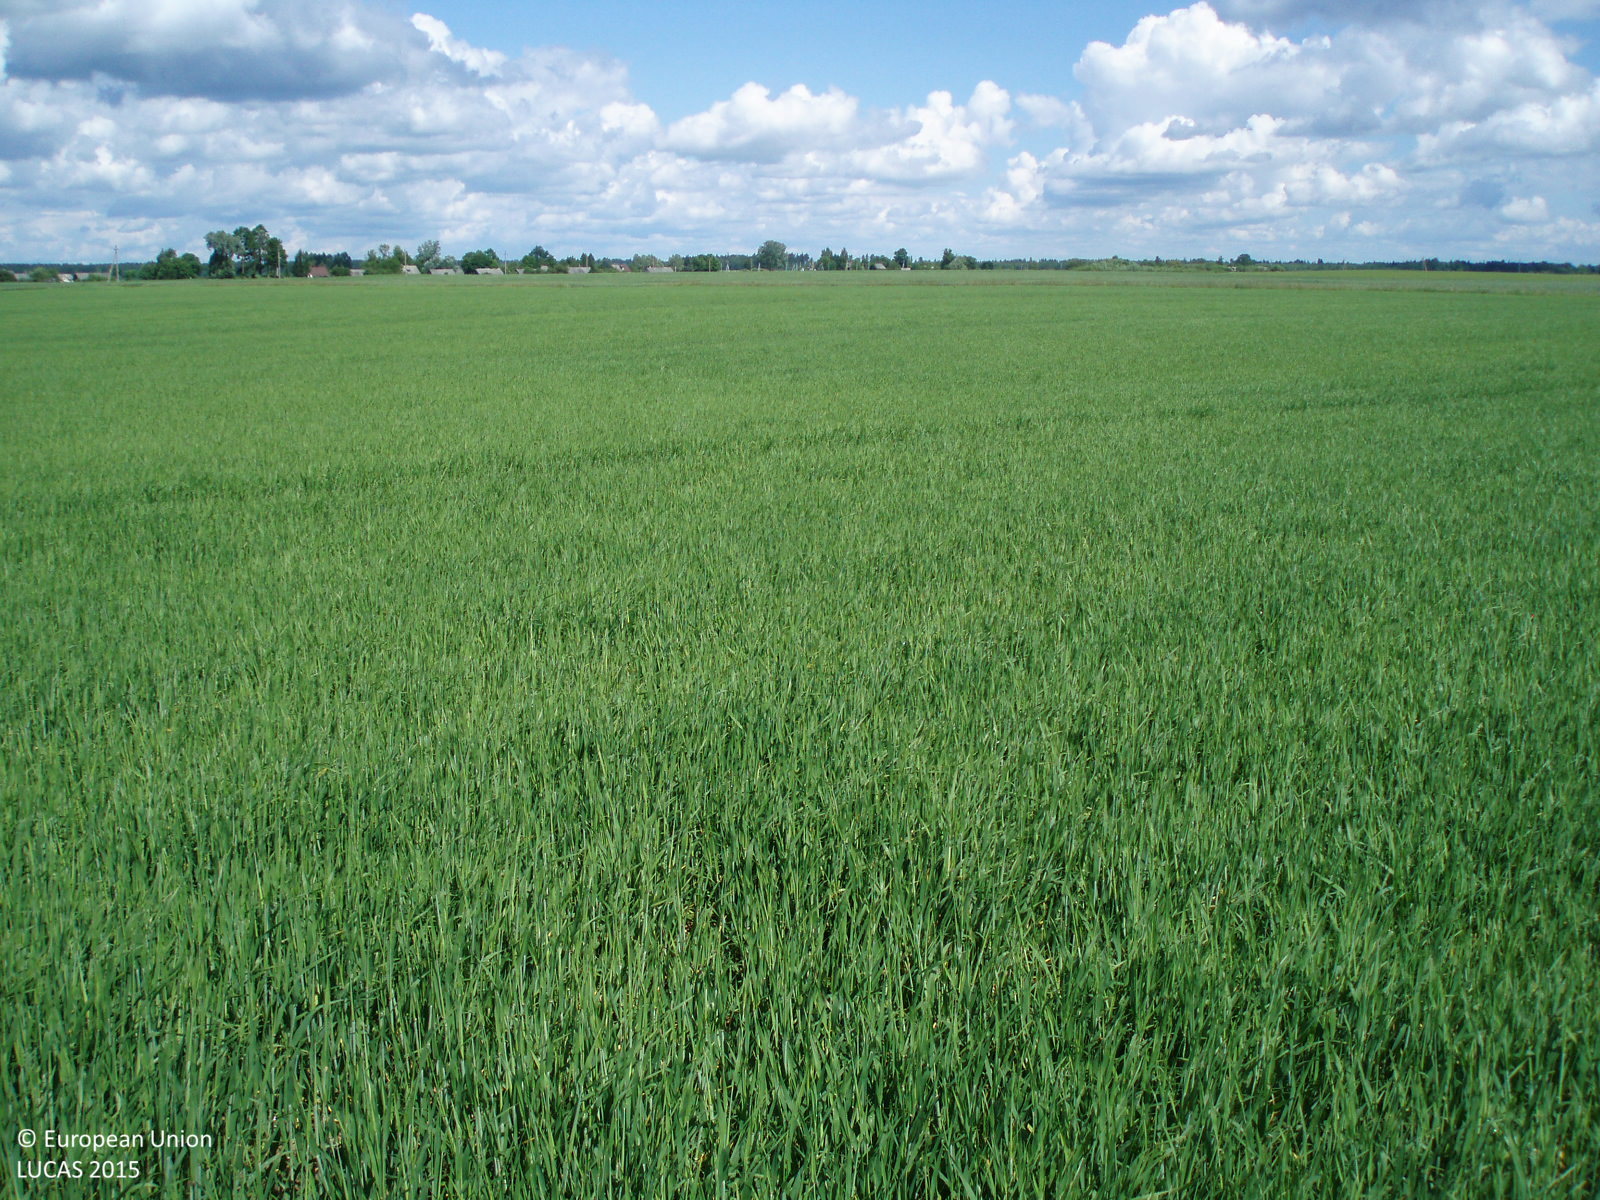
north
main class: Cropland
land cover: Barley
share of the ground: > 75 %
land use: Agriculture (excluding fallow land and kitchen gardens)
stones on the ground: < 10 %
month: June
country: LT
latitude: 56.2619
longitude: 23.2614
